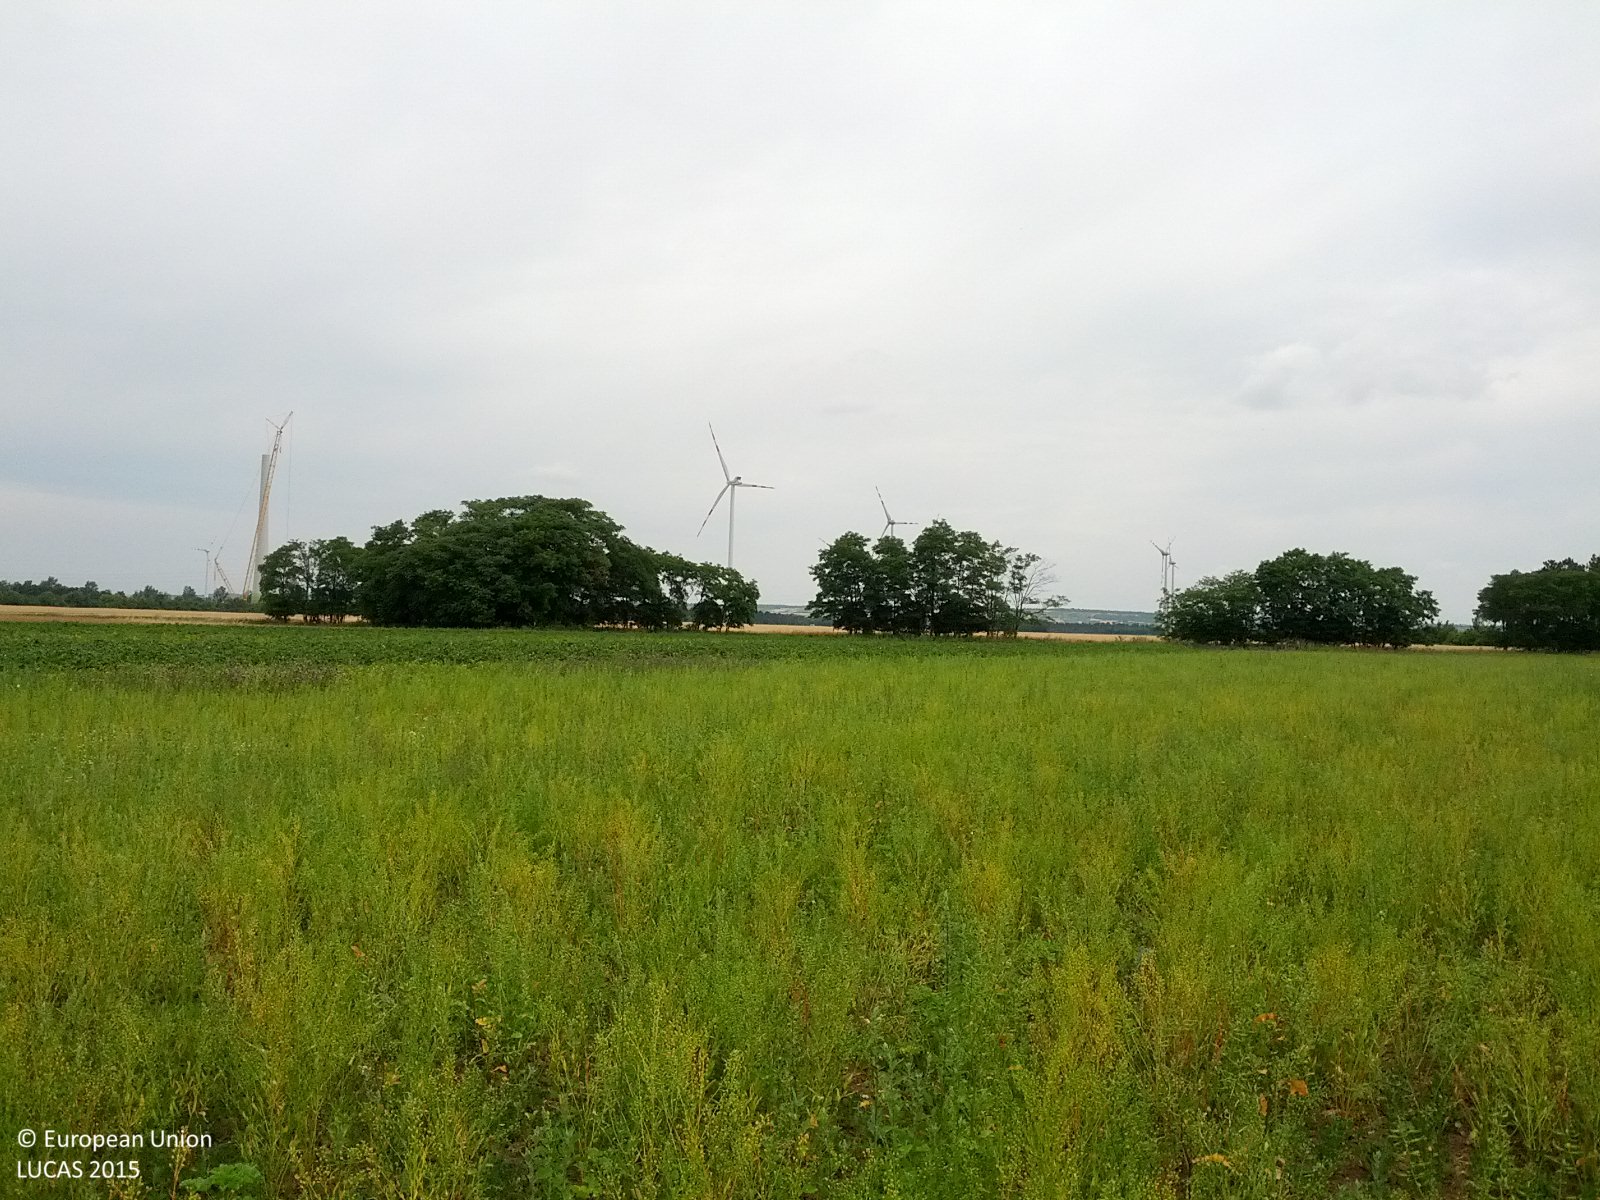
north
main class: Cropland
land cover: Clovers
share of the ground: 25 - 50 %
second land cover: Other fibre and oleaginous crops
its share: 25 - 50 %
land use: Agriculture (excluding fallow land and kitchen gardens)
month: June
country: AT
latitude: 48.3178
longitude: 16.5463
